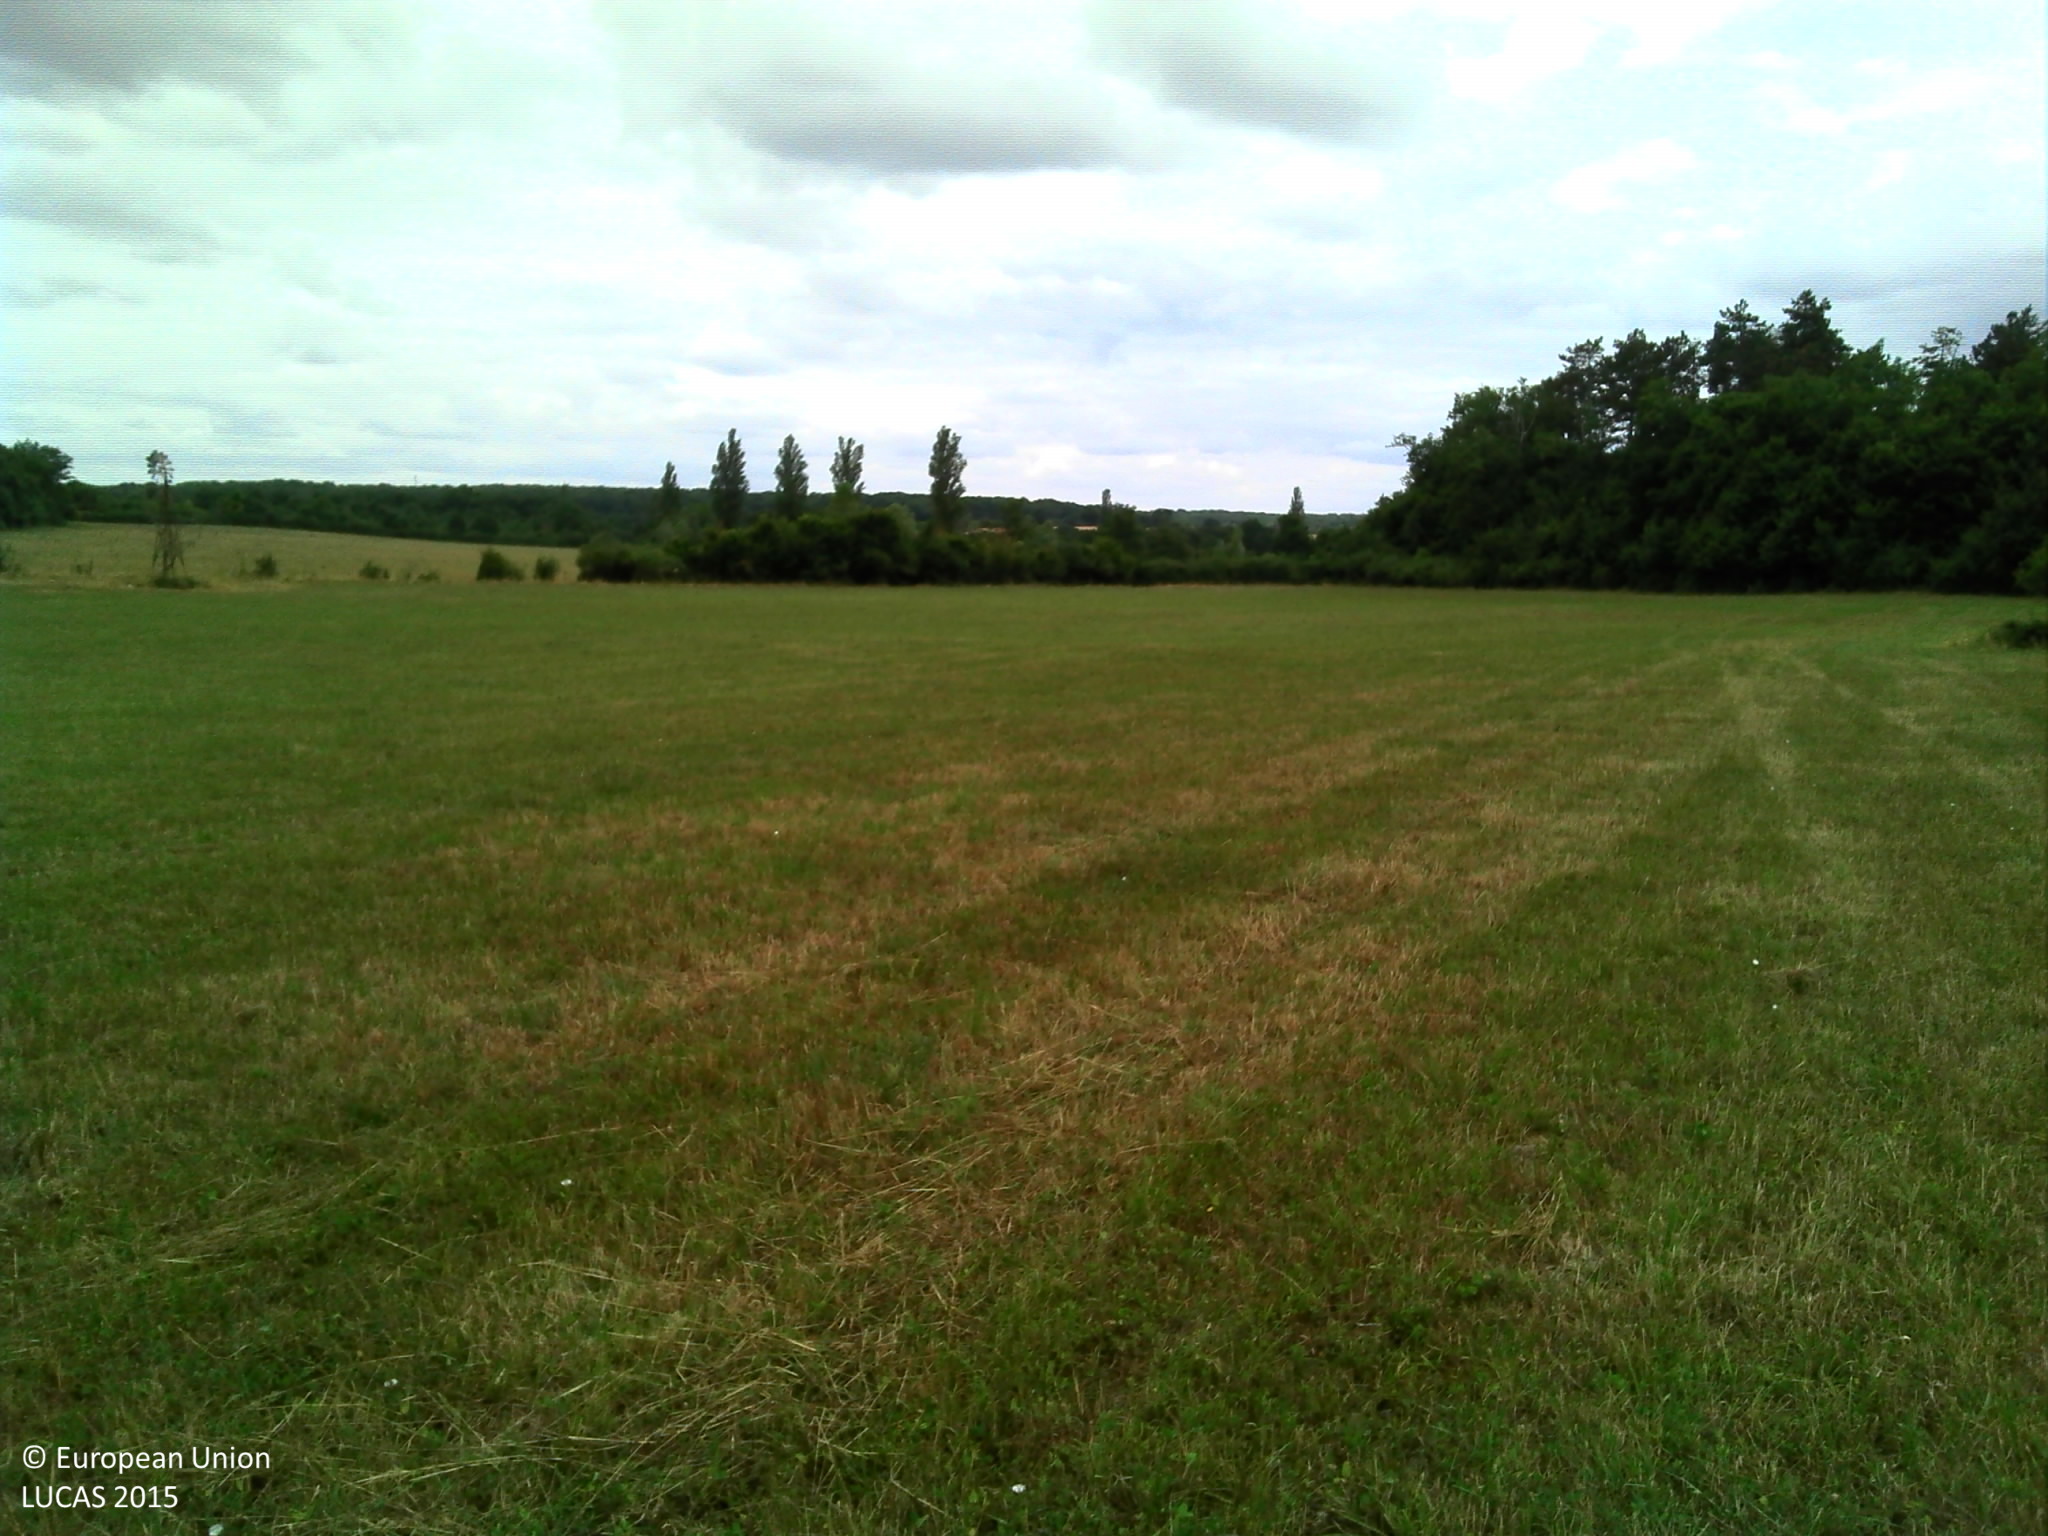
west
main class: Grassland
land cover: Grassland without tree/shrub cover
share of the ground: > 75 %
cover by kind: herbaceous plants 100 %
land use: Agriculture (excluding fallow land and kitchen gardens)
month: July
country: FR
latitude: 46.8031
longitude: 3.1964
